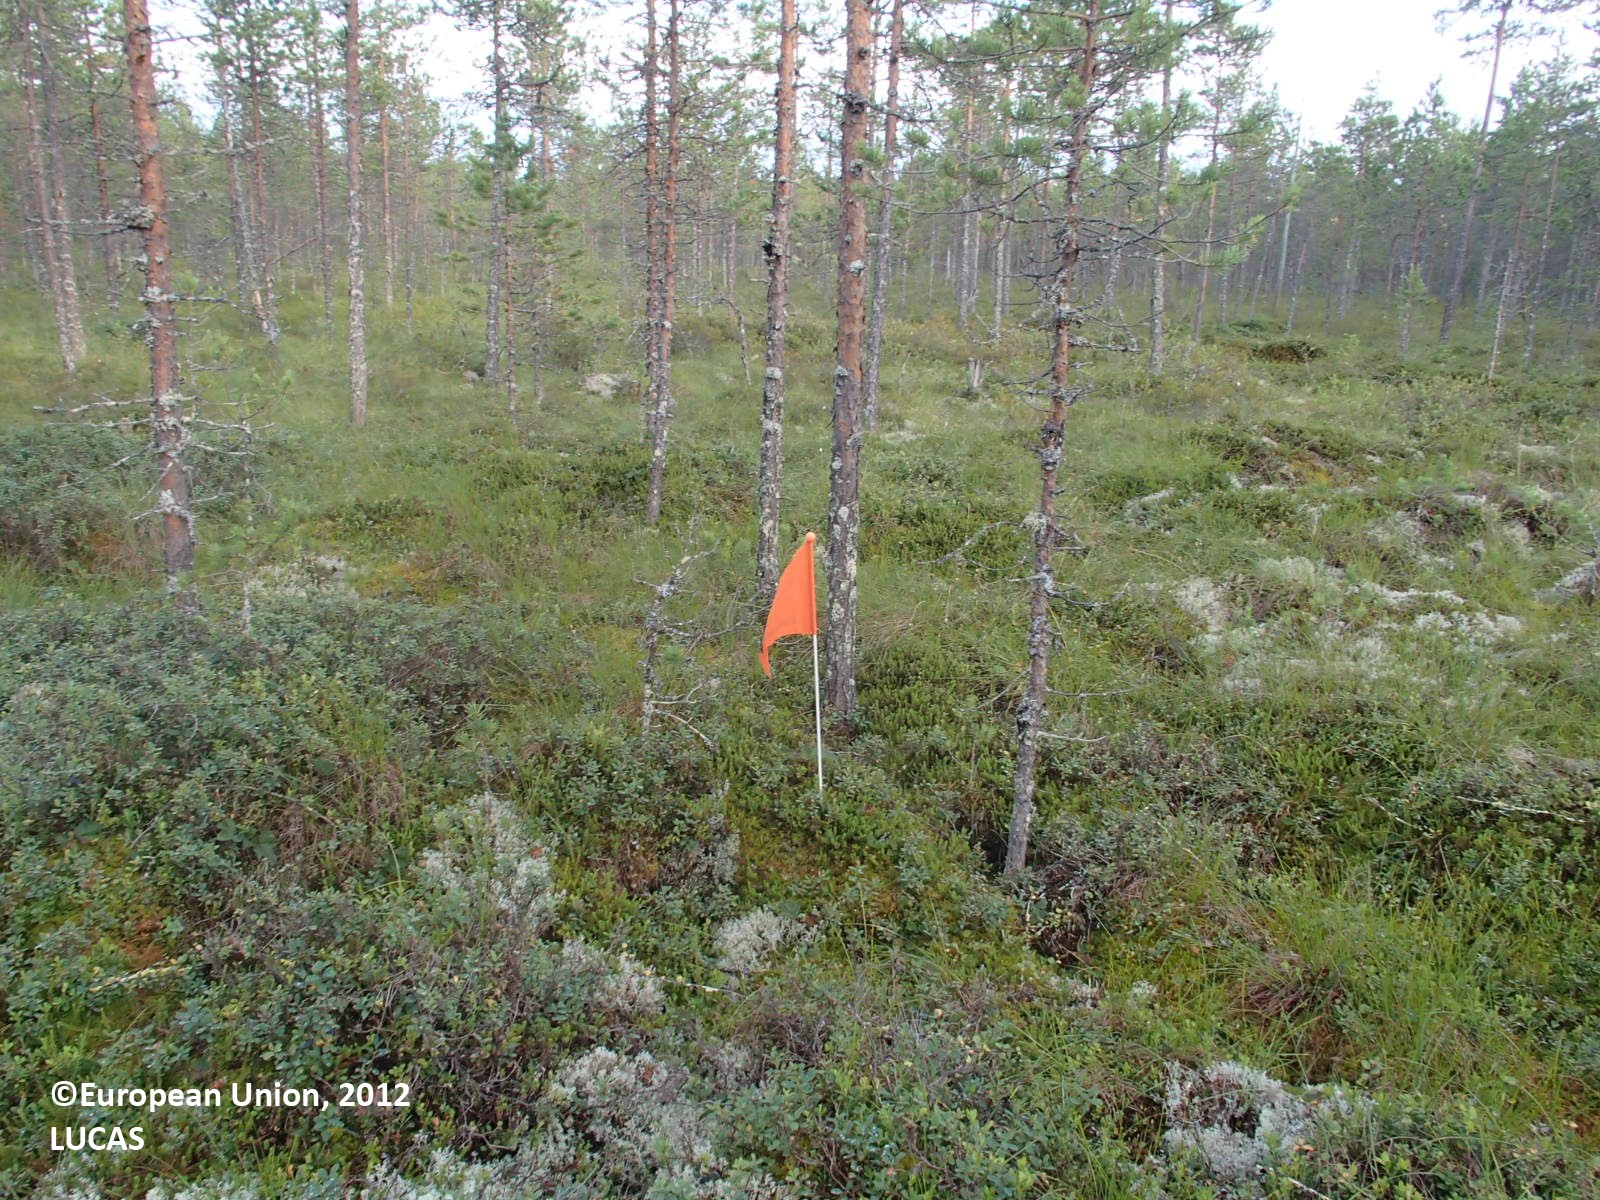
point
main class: Woodland
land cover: Pine dominated coniferous woodland
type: boreal forest
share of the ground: 10 - 25 %
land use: Forestry
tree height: > 5 m
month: August
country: FI
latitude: 64.1011
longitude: 26.1361
